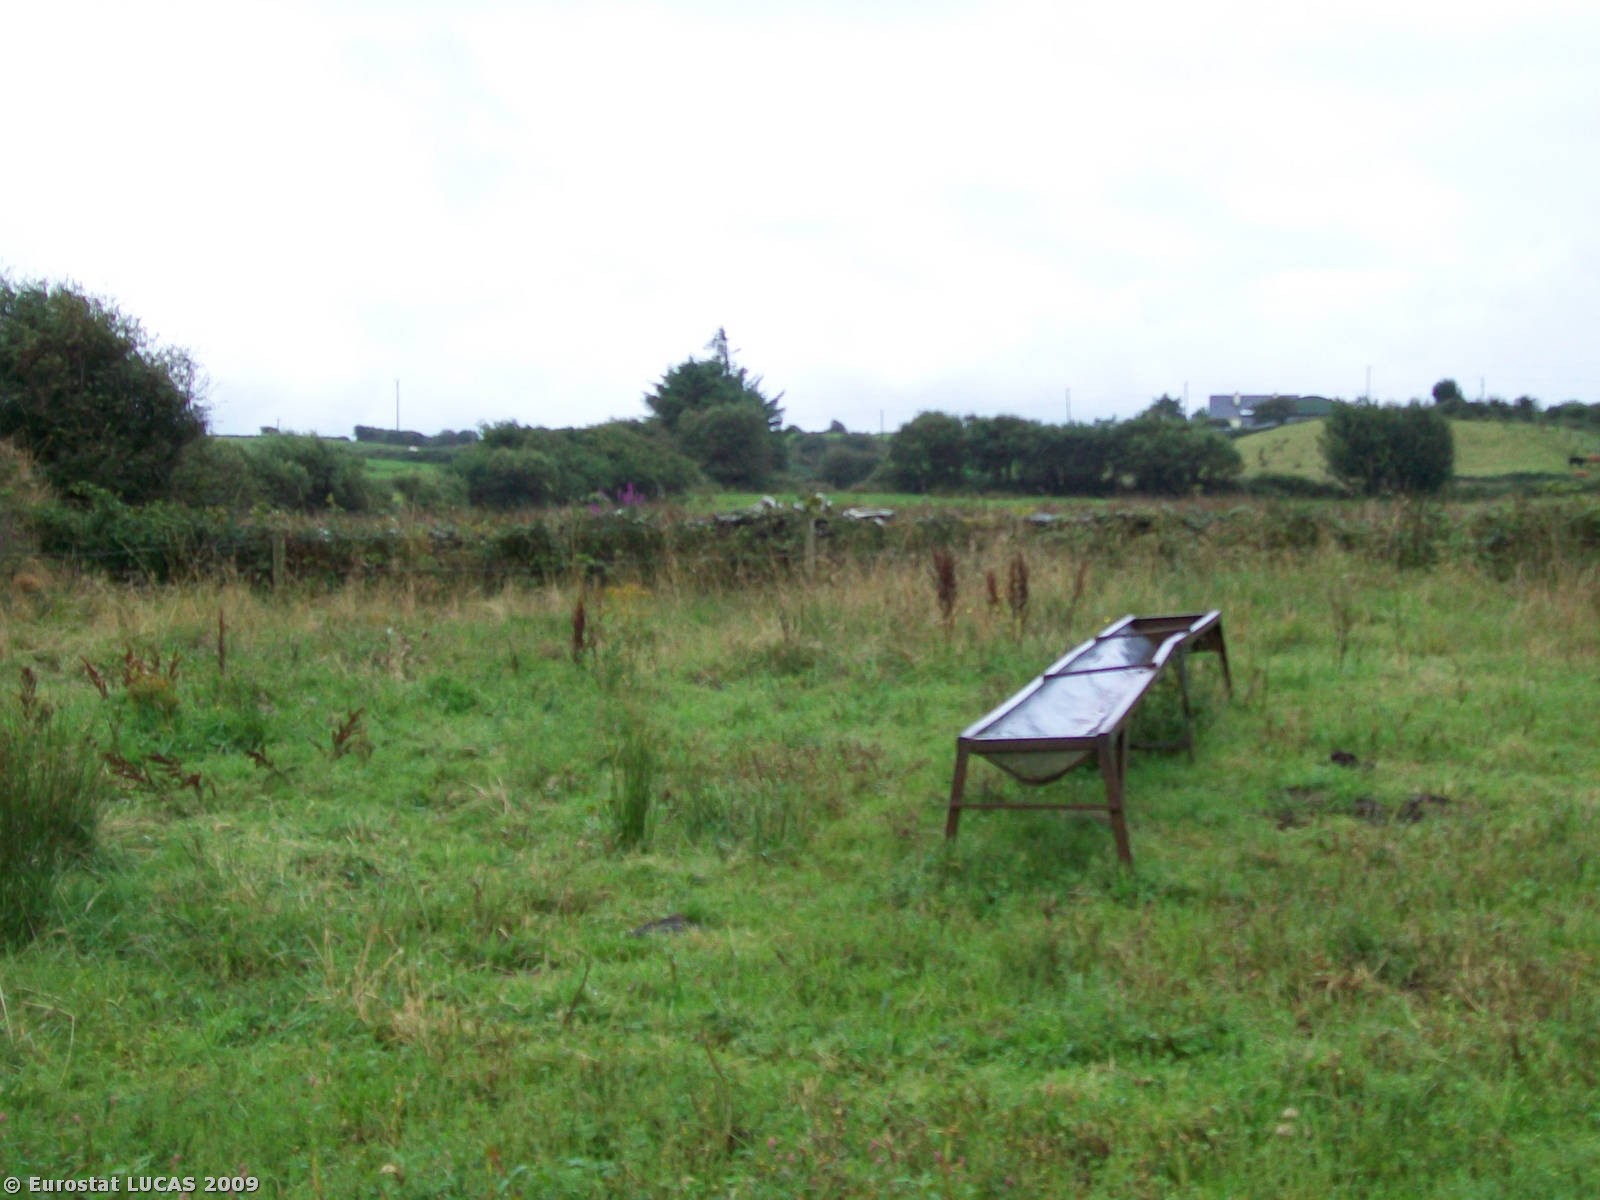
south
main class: Grassland
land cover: Grassland without tree/shrub cover
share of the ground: > 75 %
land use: Agriculture (excluding fallow land and kitchen gardens)
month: August
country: IE
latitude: 52.9106
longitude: -9.2410
